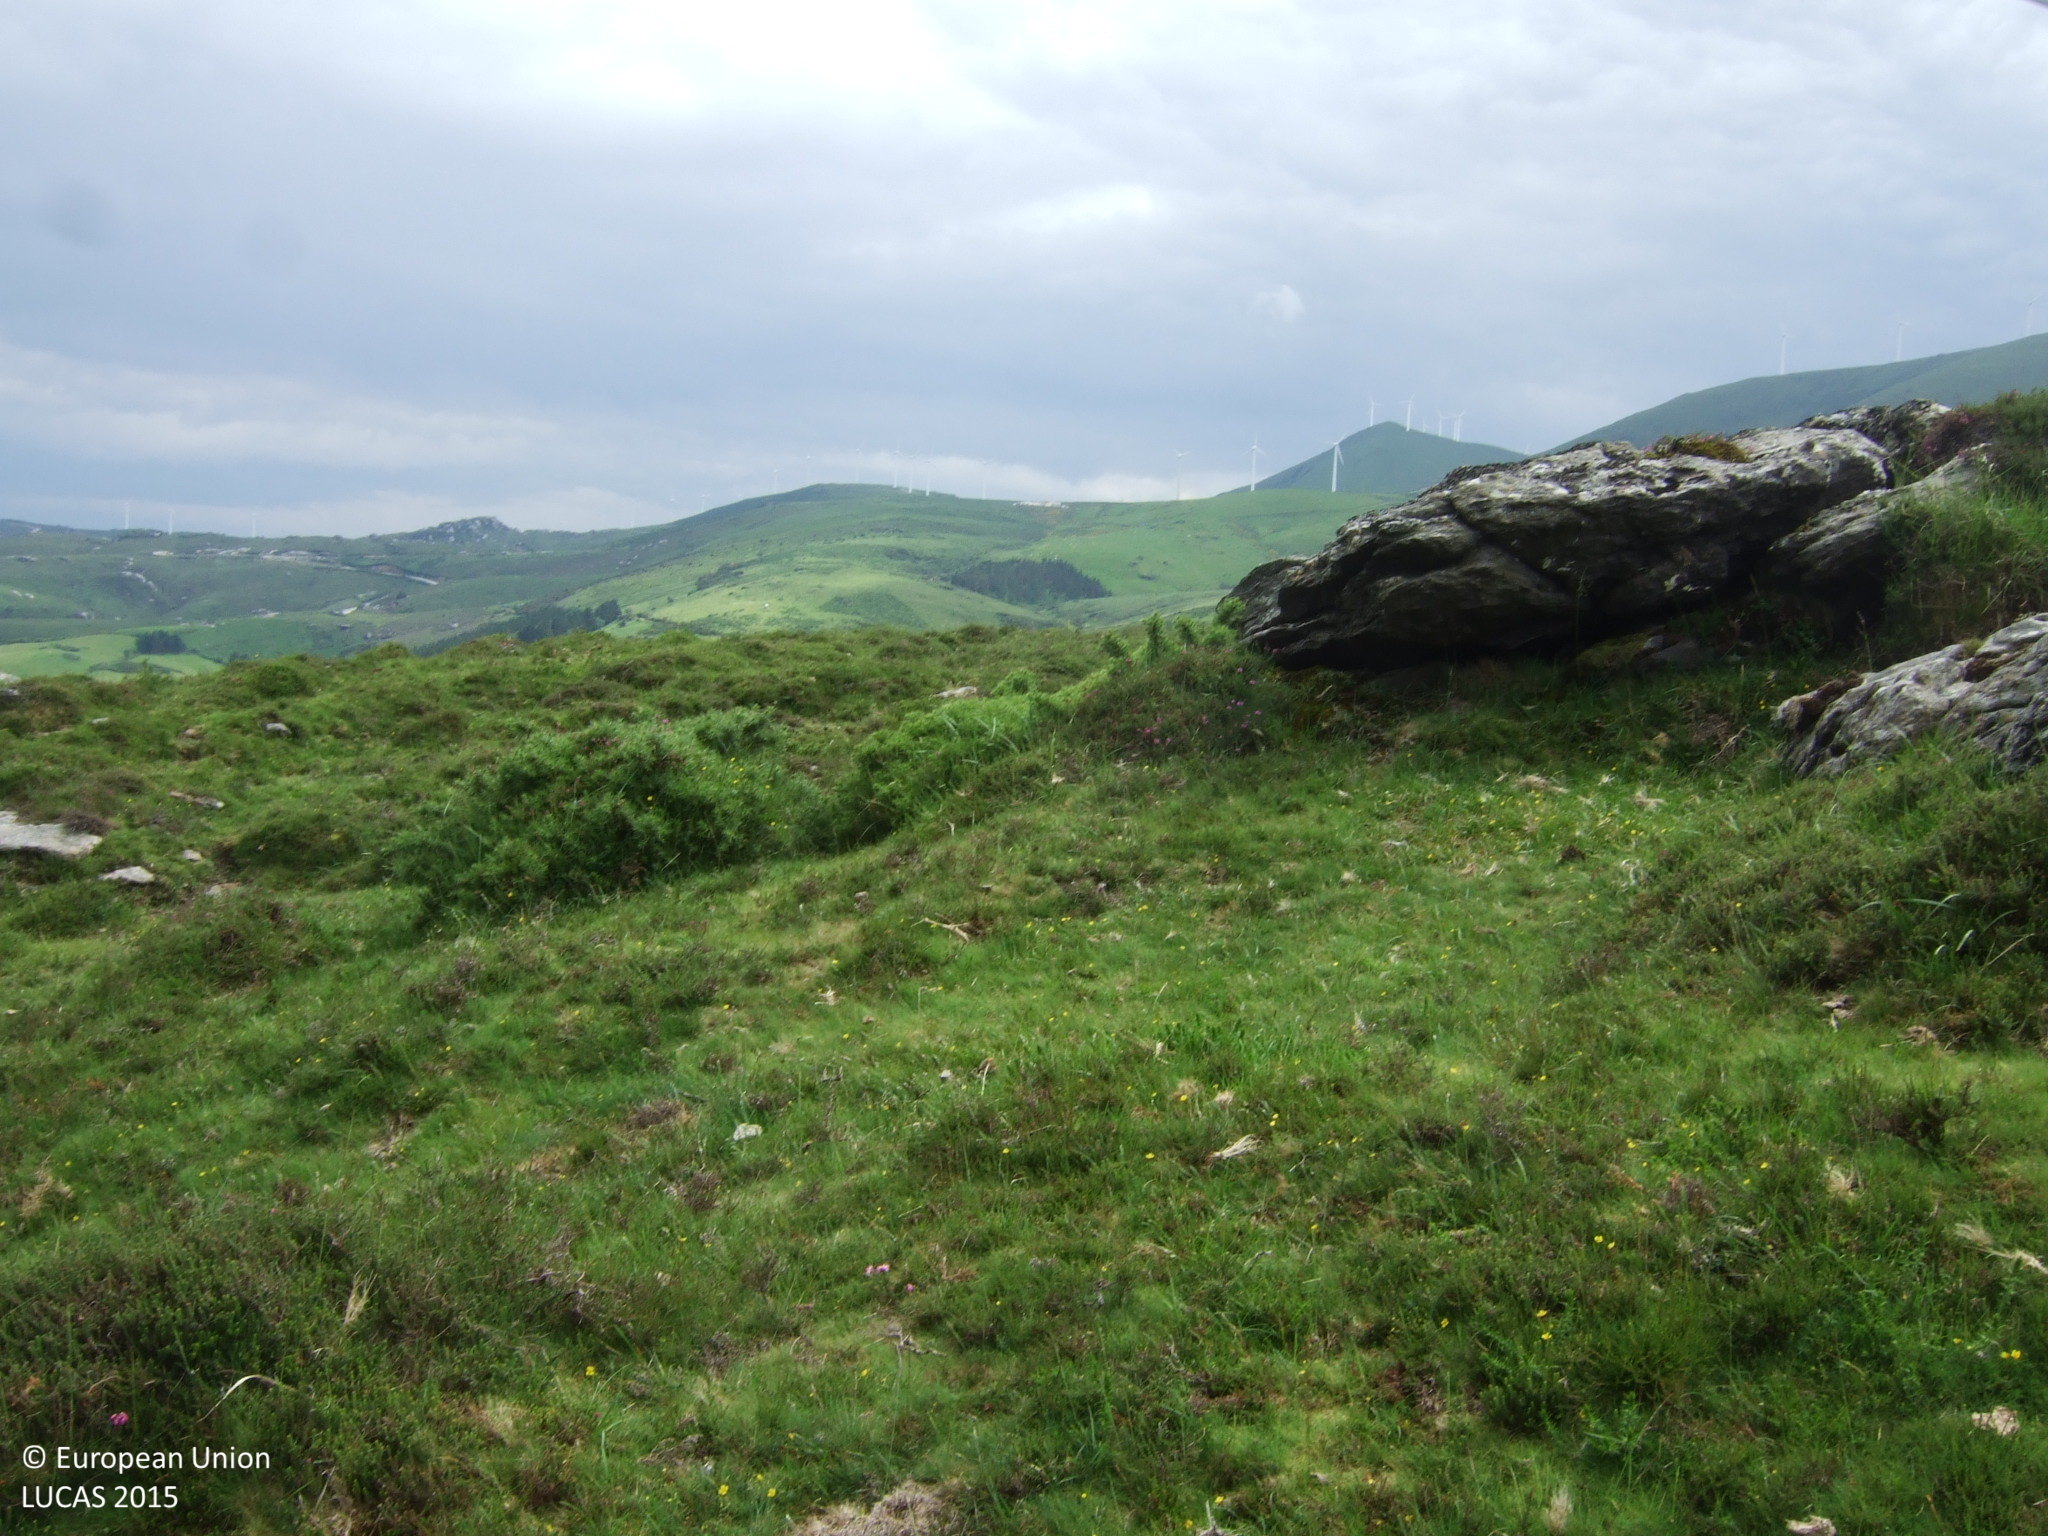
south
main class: Shrubland
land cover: Shrubland without tree cover
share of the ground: > 75 %
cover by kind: herbaceous plants 60 %, shrubs 40 %
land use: Agriculture (excluding fallow land and kitchen gardens)
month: June
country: ES
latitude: 43.4889
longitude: -7.5296
